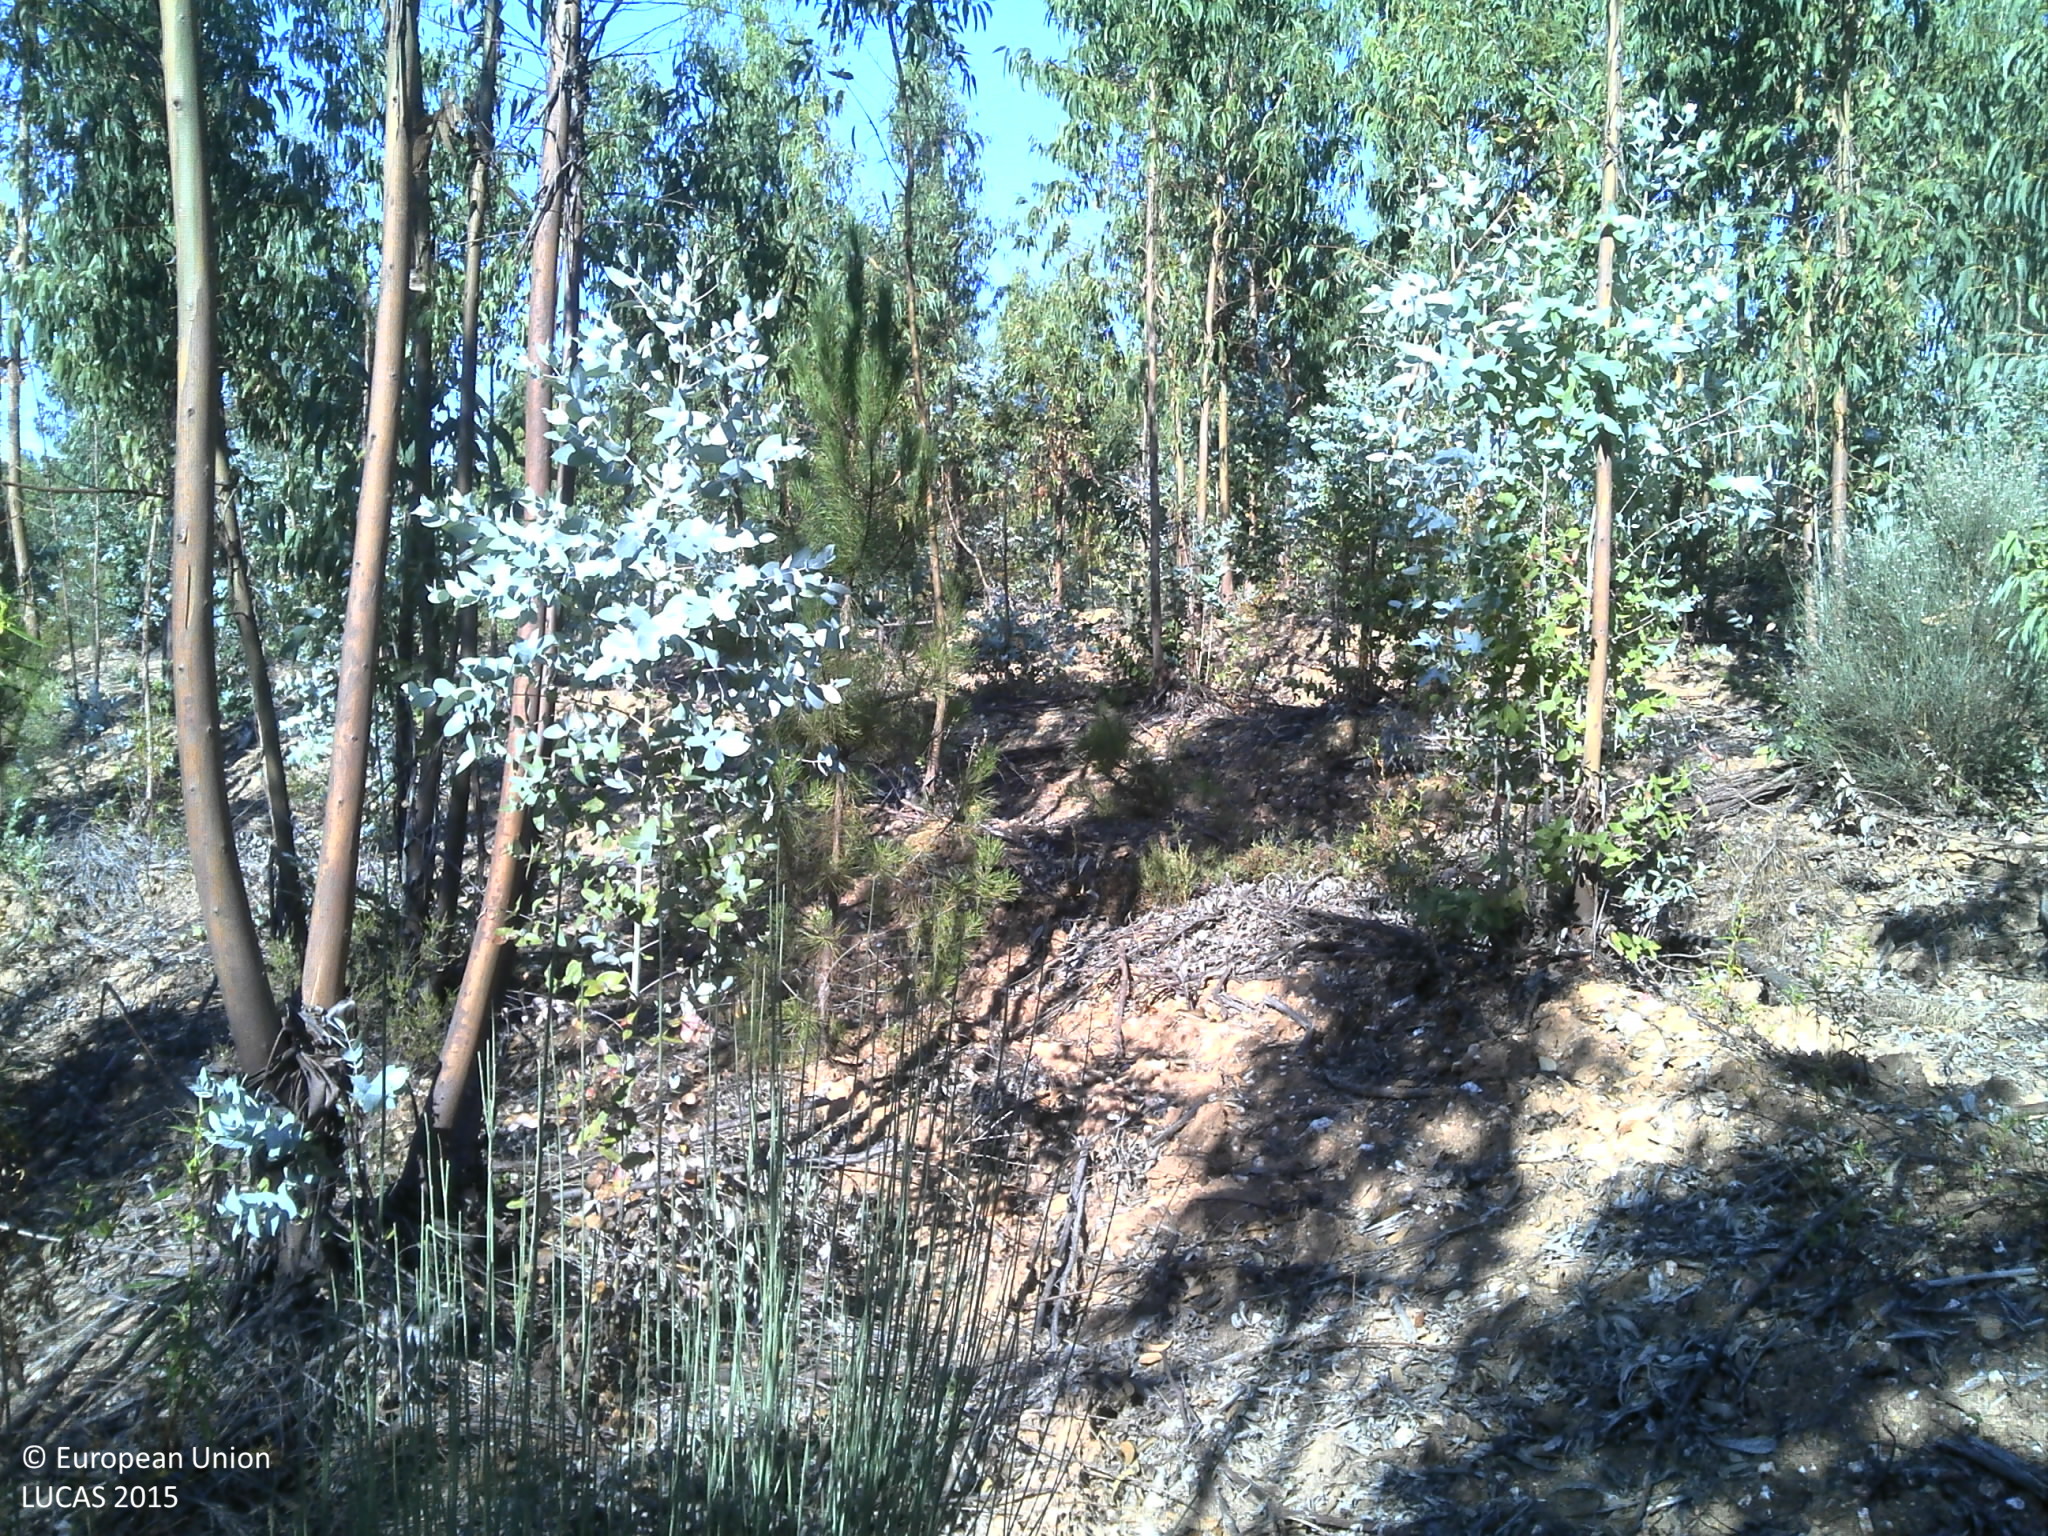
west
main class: Woodland
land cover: Broadleaved woodland
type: exotic forest
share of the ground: 25 - 50 %
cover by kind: broadleaved forest trees 50 %, unconsolidated bare surface 35 %, shrubs 15 %
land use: Forestry
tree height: > 5 m
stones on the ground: 10 - 25 %
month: July
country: PT
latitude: 39.7782
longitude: -7.5547
